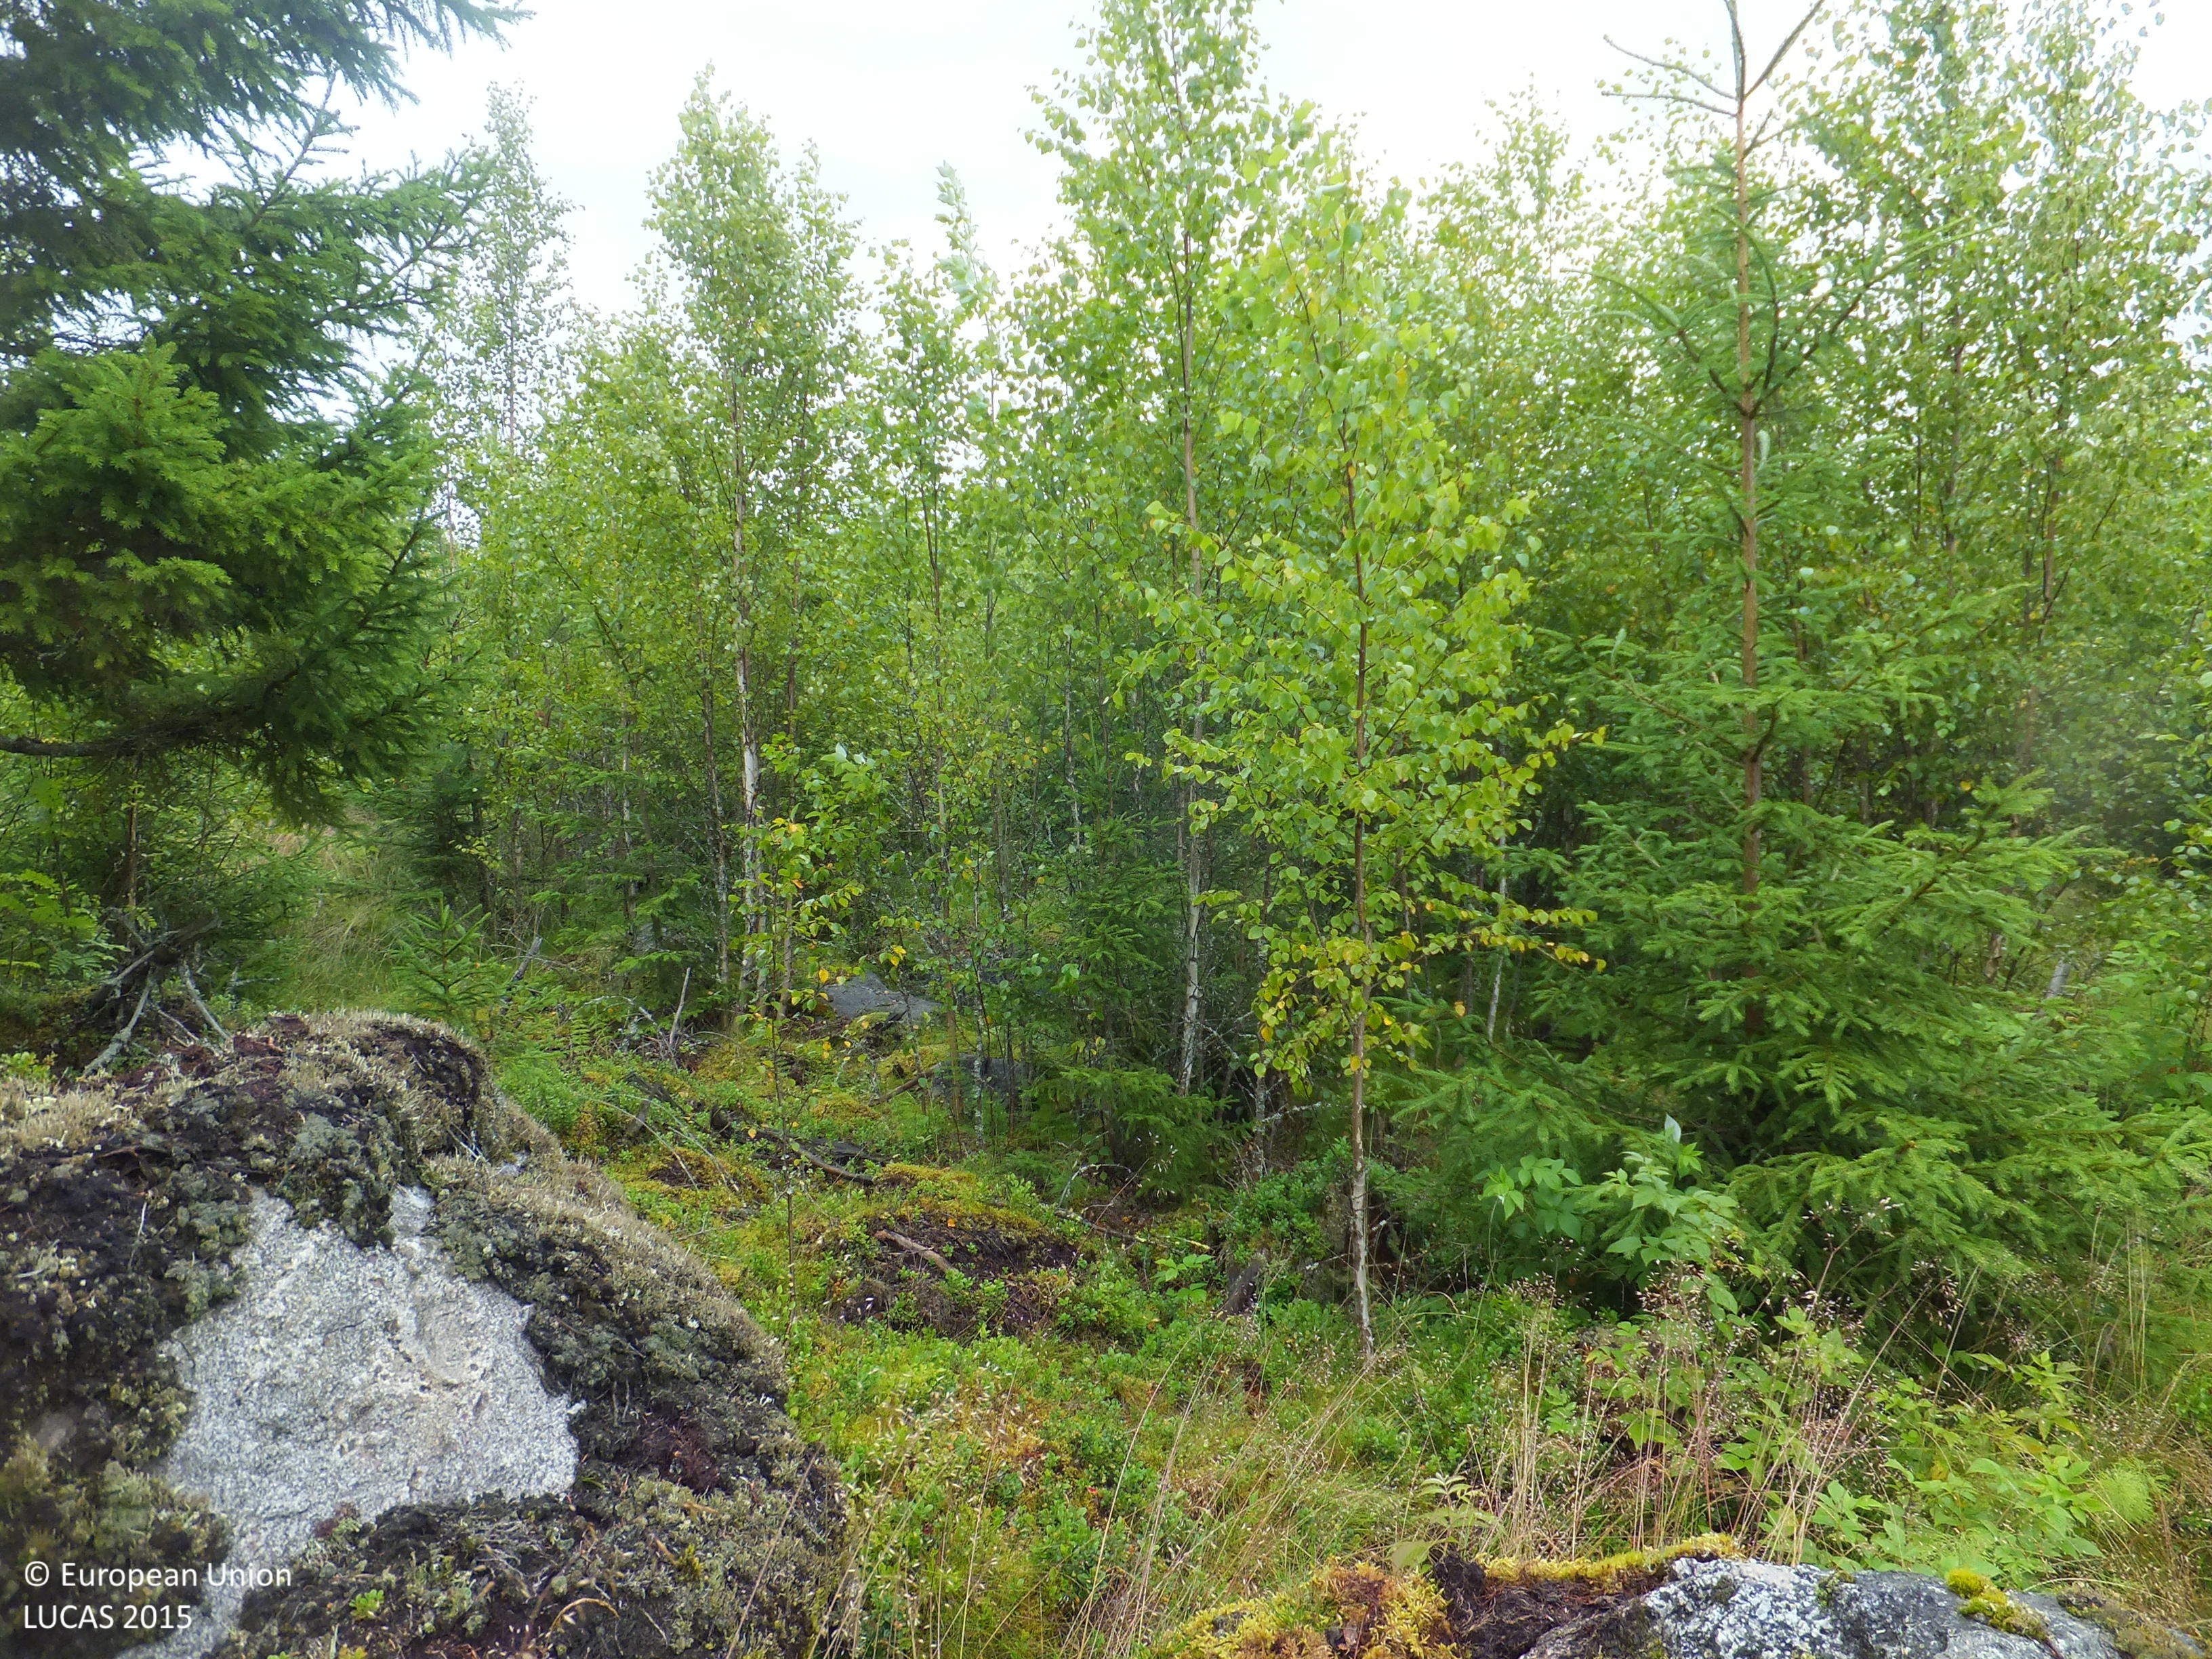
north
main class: Woodland
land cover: Spruce dominated mixed woodland
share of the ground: 10 - 25 %
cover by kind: shrubs 30 %, herbaceous plants 20 %, lichens and mosses 20 %, coniferous forest trees 10 %, broadleaved forest trees 10 %, consolidated bare surface 10 %
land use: Forestry
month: July
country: FI
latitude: 63.0324
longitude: 21.9231
